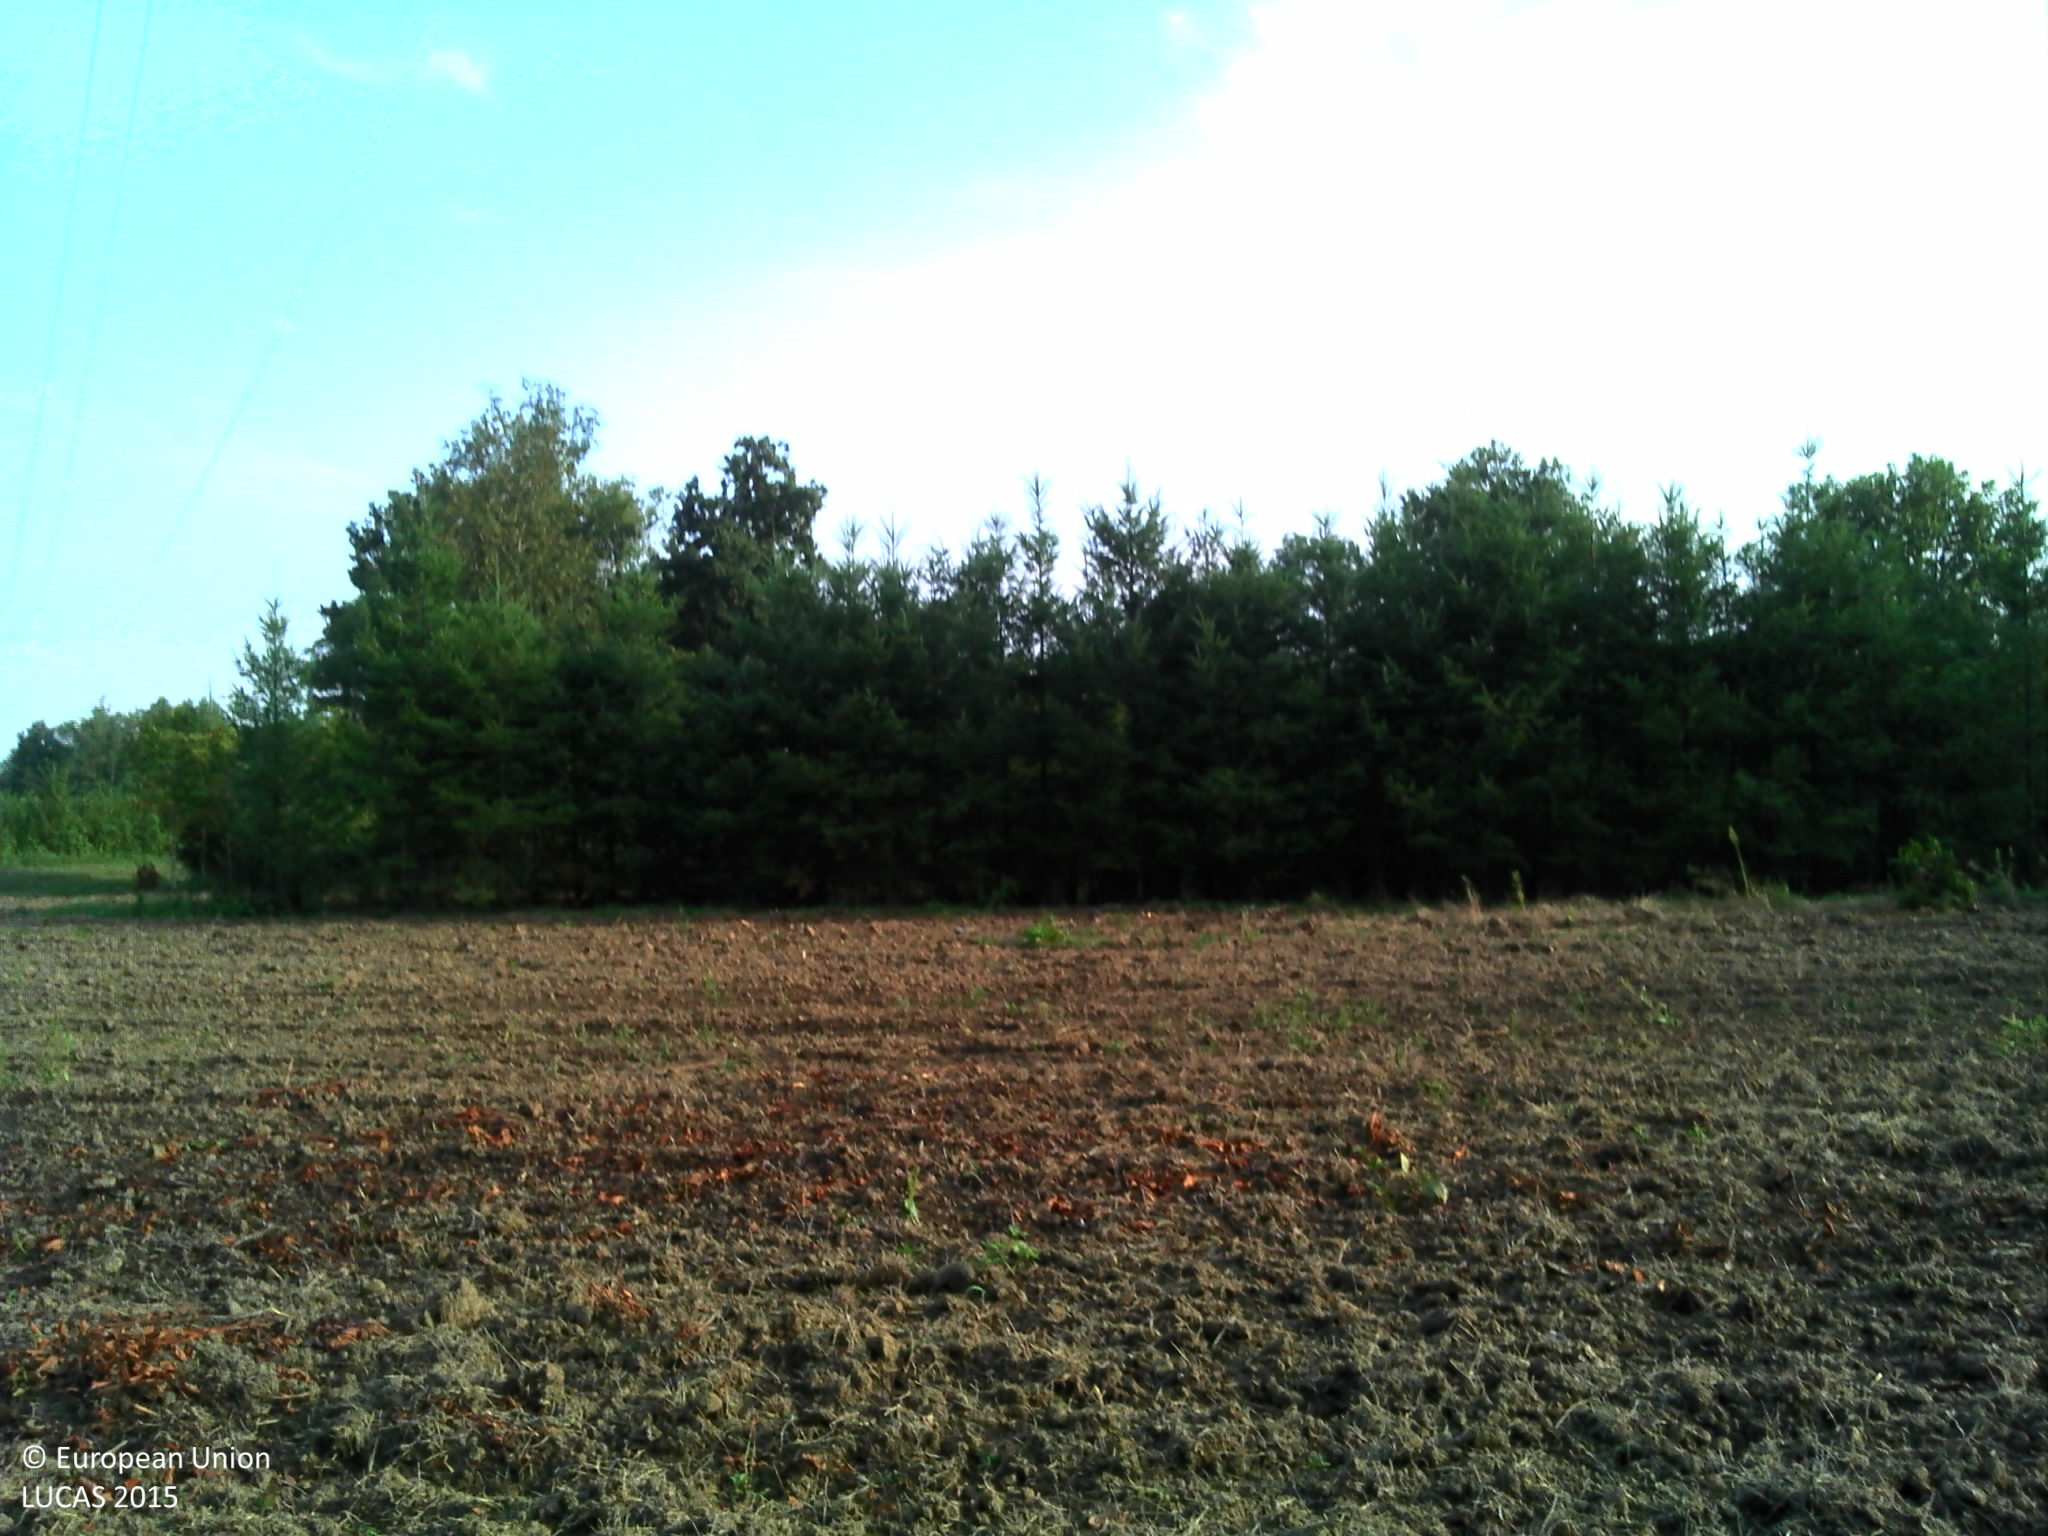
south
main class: Woodland
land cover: Broadleaved woodland
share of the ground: > 75 %
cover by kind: broadleaved forest trees 80 %, herbaceous plants 10 %, unconsolidated bare surface 10 %
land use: Semi-natural and natural areas not in use
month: August
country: FR
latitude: 45.6472
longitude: 4.1133
